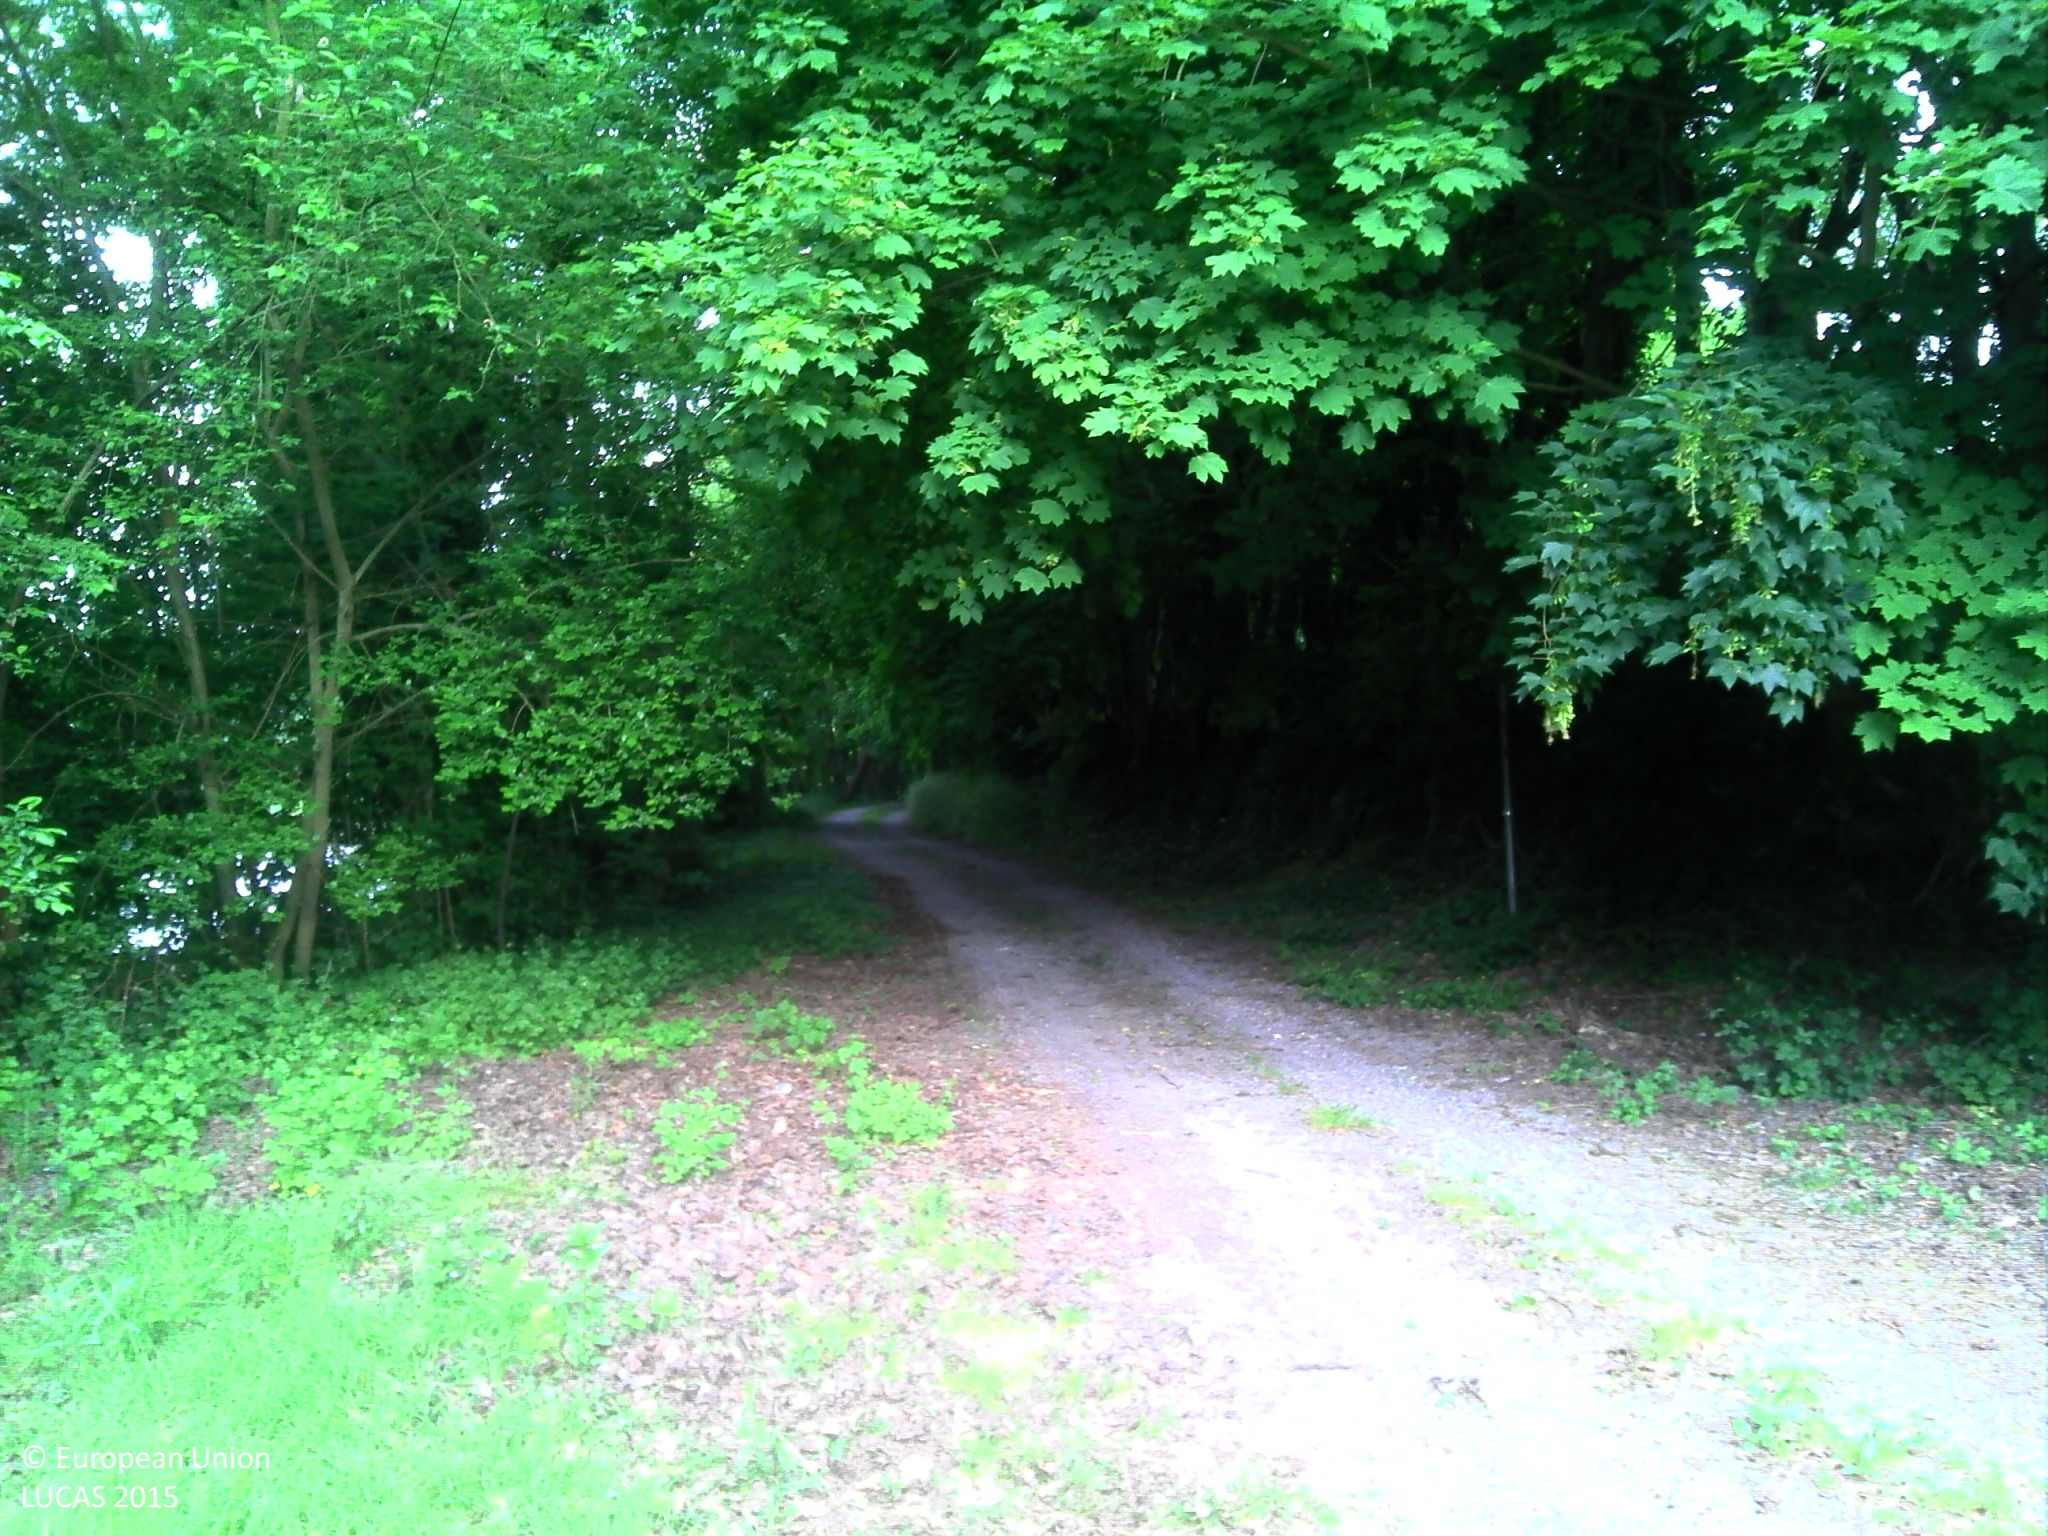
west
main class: Grassland
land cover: Spontaneously vegetated surfaces
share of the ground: > 75 %
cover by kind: herbaceous plants 80 %, unconsolidated bare surface 20 %
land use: Semi-natural and natural areas not in use
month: May
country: BE
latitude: 50.4479
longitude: 4.8848
